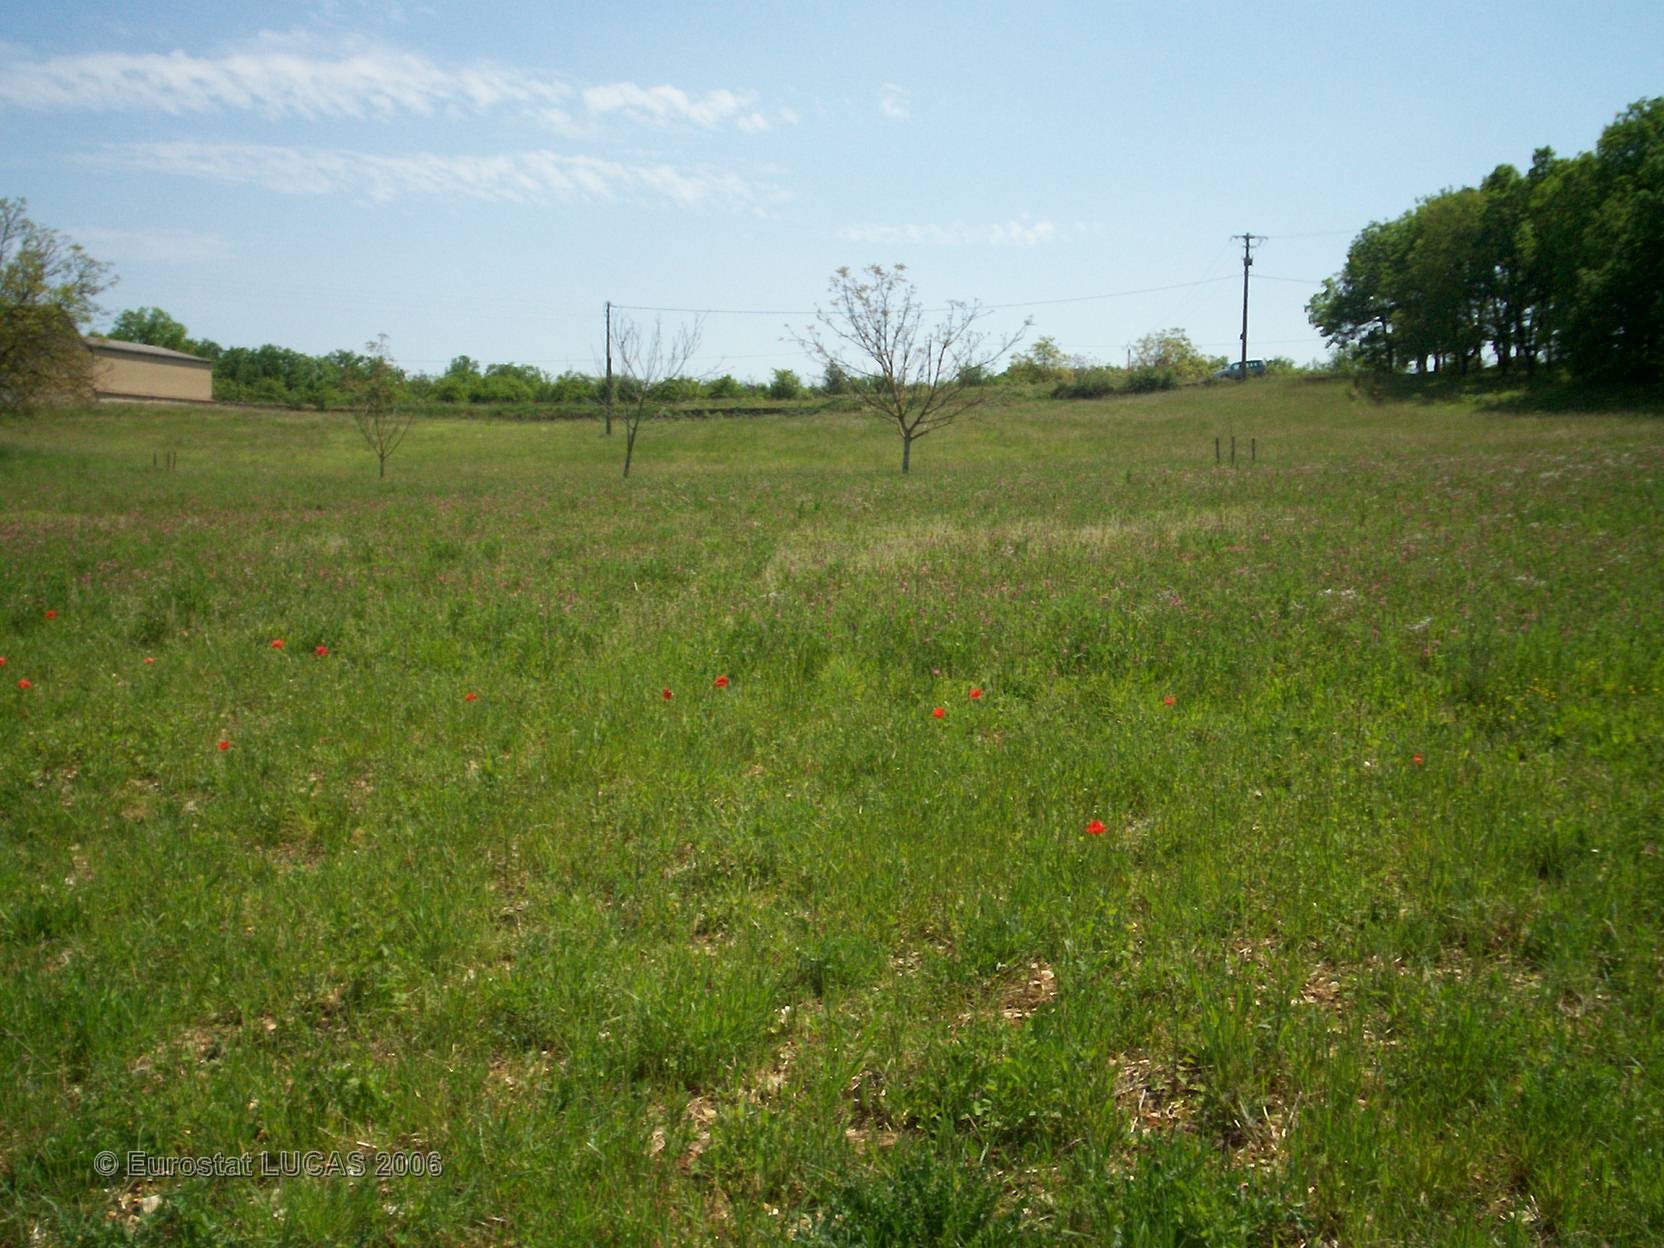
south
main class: Grassland
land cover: Grassland without tree/shrub cover
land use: Agriculture (excluding fallow land and kitchen gardens)
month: May
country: FR
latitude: 44.5687
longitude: 1.3465
